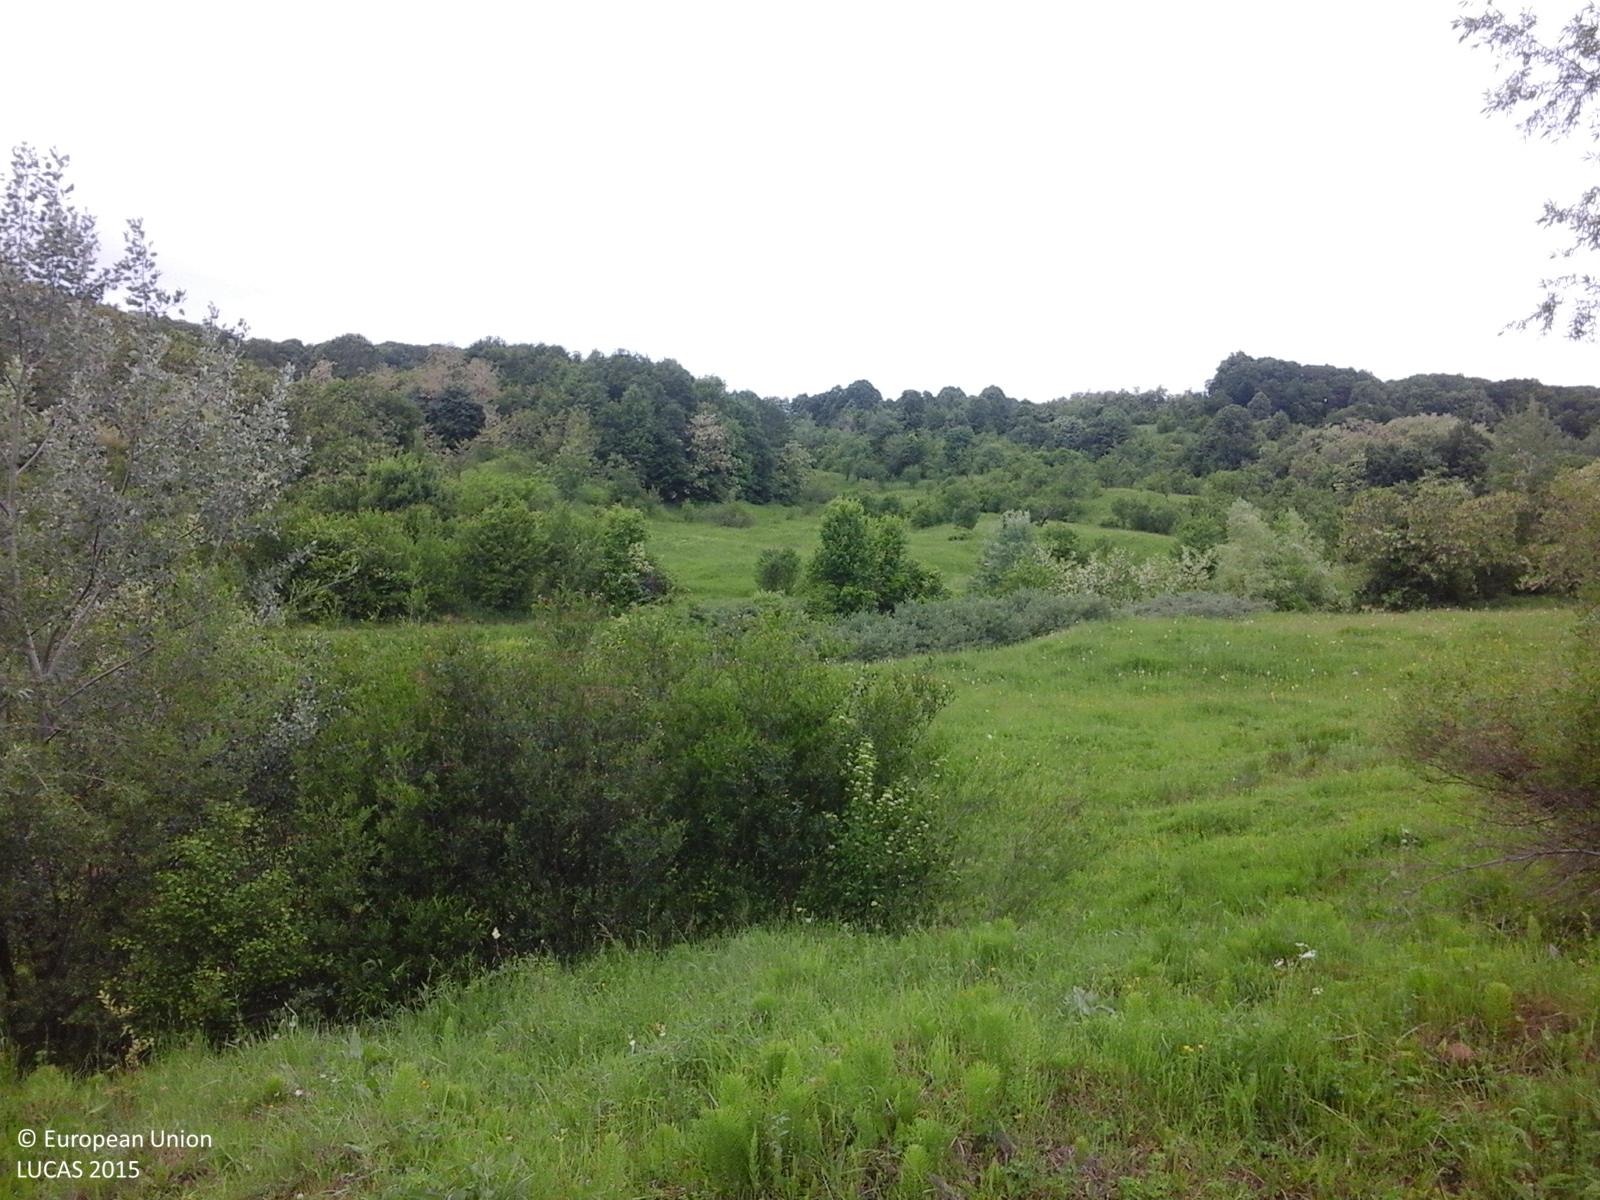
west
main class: Grassland
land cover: Grassland with sparse tree/shrub cover
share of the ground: > 75 %
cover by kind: herbaceous plants 85 %, shrubs 10 %, broadleaved forest trees 5 %
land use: Agriculture (excluding fallow land and kitchen gardens)
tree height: < 5 m
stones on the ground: < 10 %
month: May
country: RO
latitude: 45.1967
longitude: 26.0877
